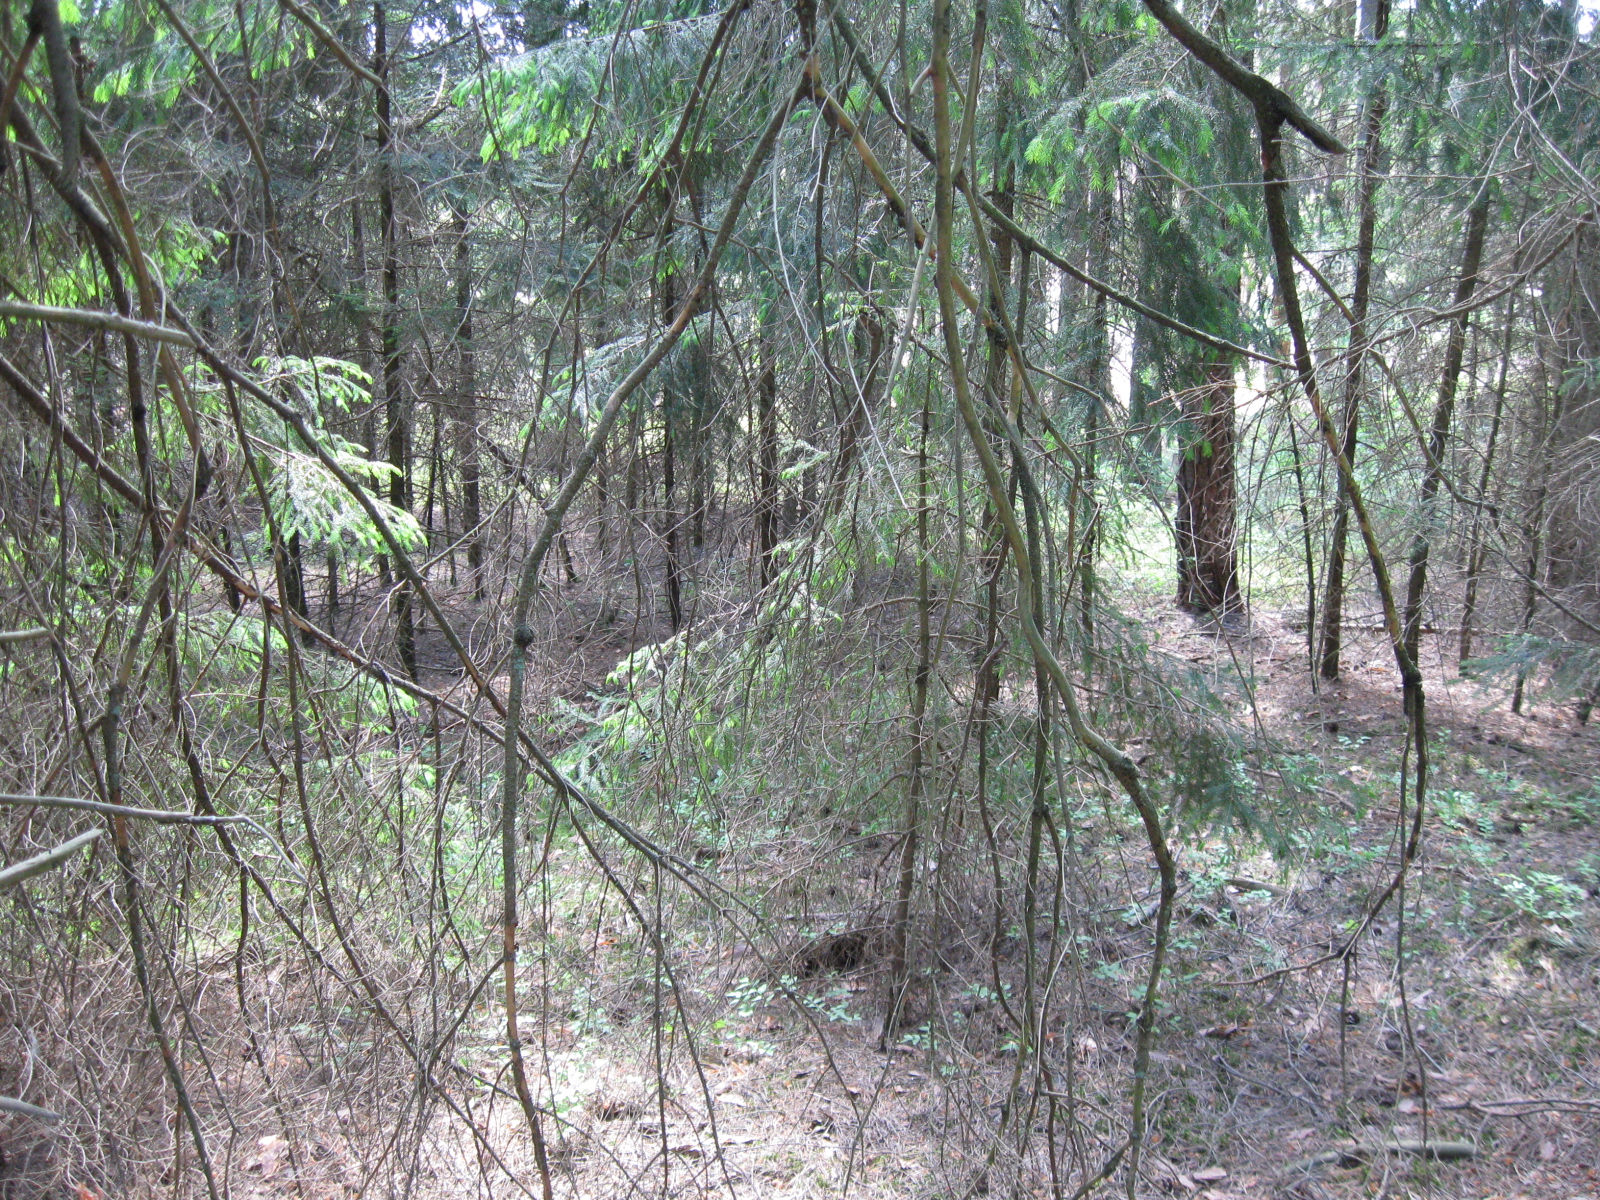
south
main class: Woodland
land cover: Other coniferous woodland
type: hemiboreal forest and nemoral coniferous forest and mixed broadleaved-coniferous forest
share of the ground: > 75 %
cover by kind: coniferous forest trees 90 %, herbaceous plants 10 %
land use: Forestry
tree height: > 5 m
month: June
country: LT
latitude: 54.6161
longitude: 23.7920
